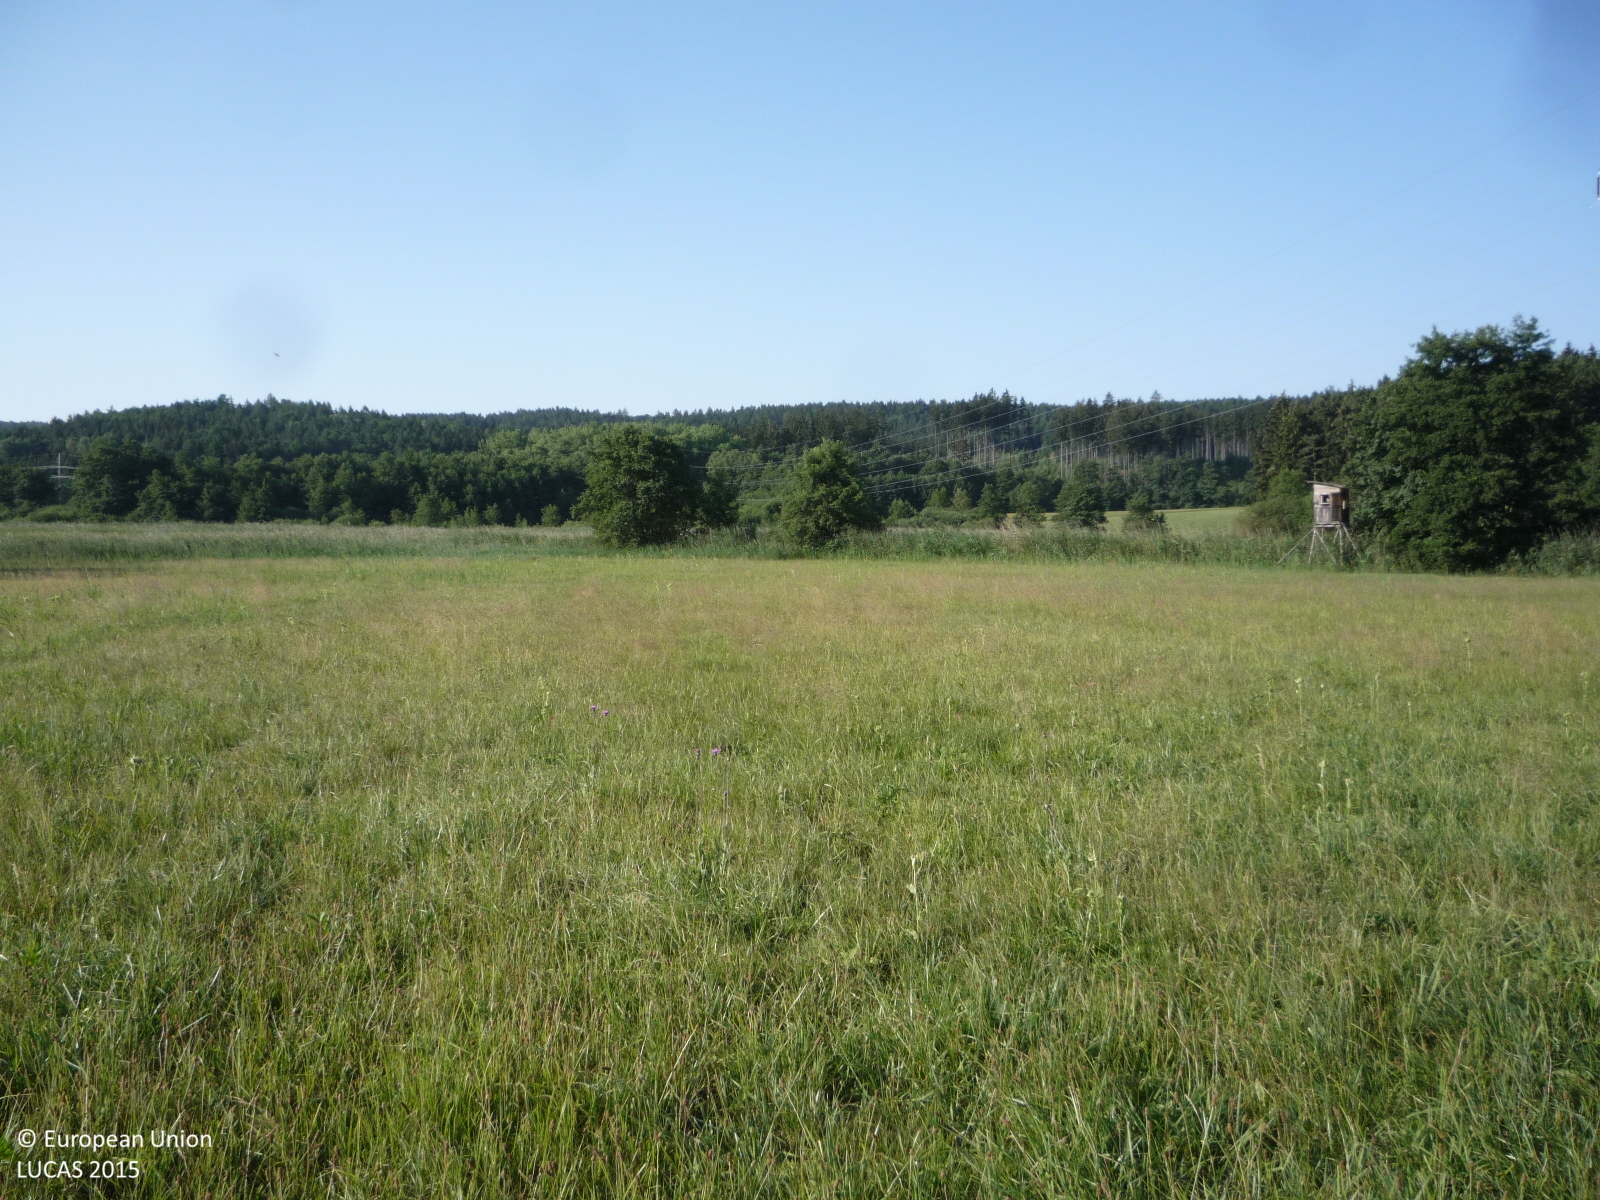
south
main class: Grassland
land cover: Grassland without tree/shrub cover
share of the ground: > 75 %
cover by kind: herbaceous plants 100 %
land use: Agriculture (excluding fallow land and kitchen gardens)
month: July
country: CZ
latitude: 50.4402
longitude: 15.2837
